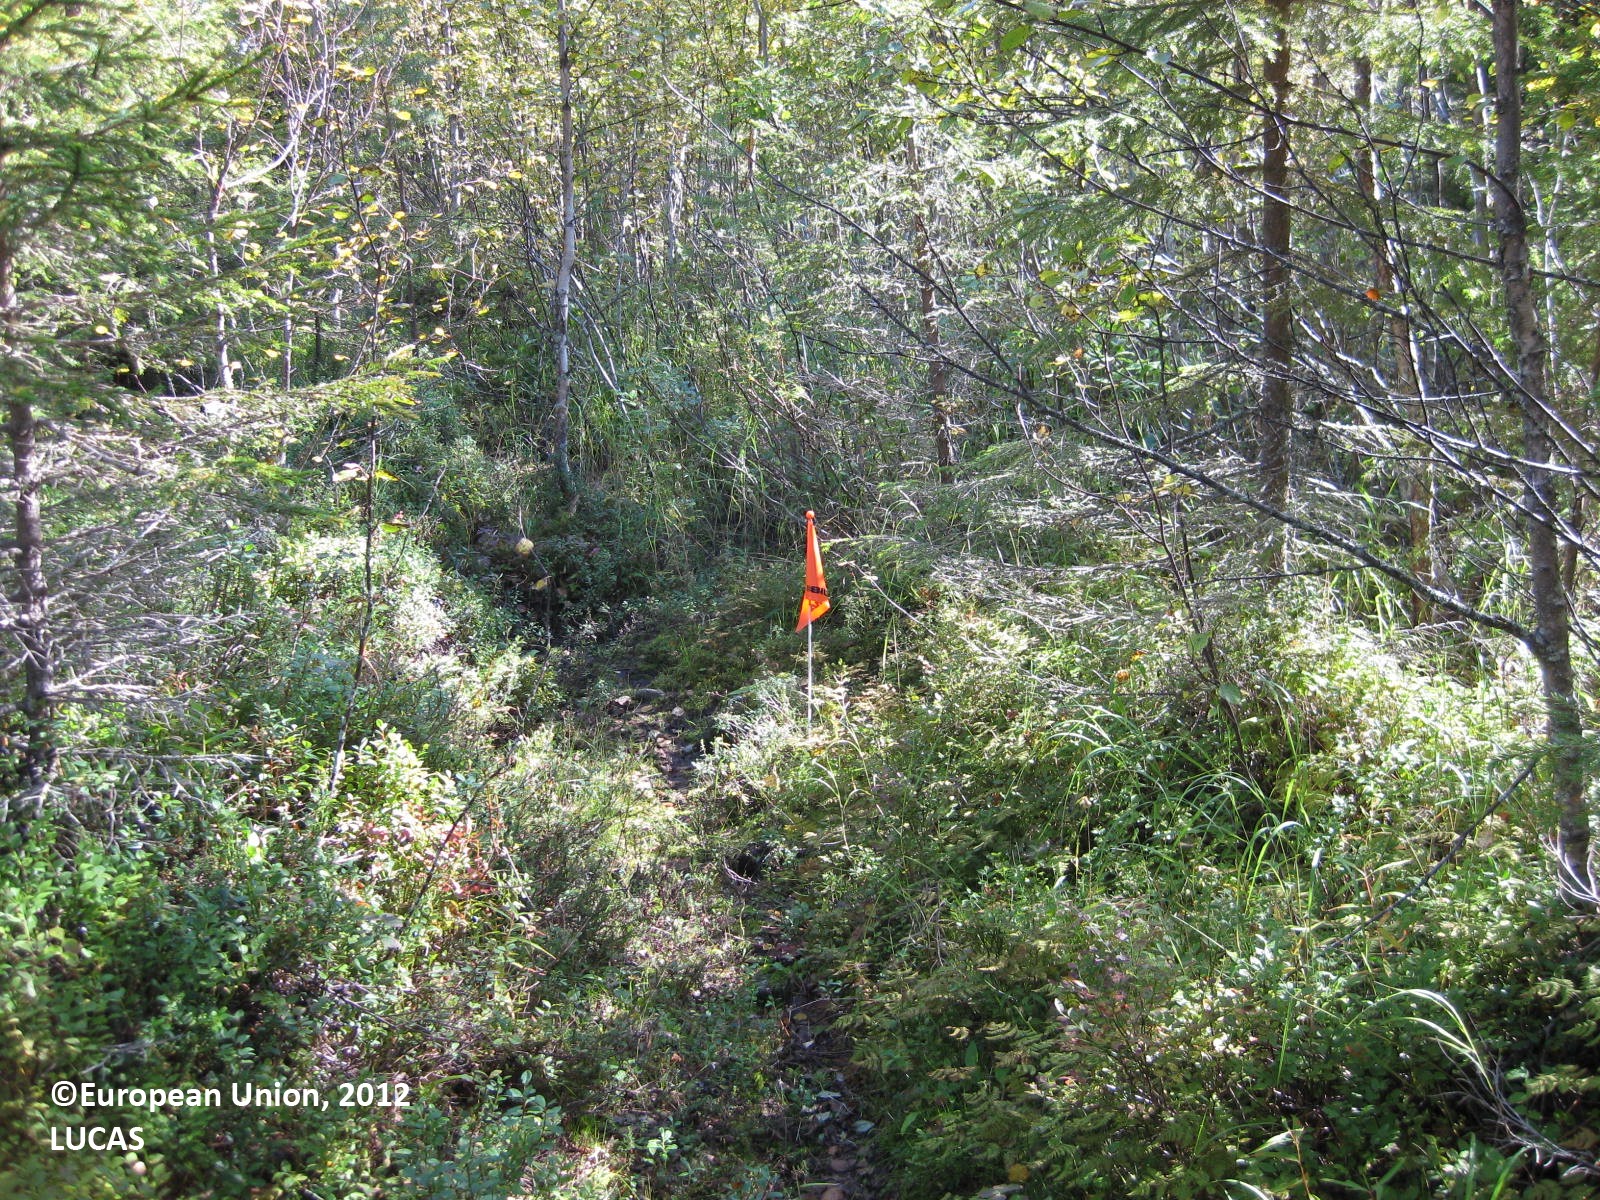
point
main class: Woodland
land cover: Other mixed woodland
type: boreal forest
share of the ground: > 75 %
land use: Forestry
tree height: > 5 m
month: August
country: FI
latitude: 66.0491
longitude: 29.7358
